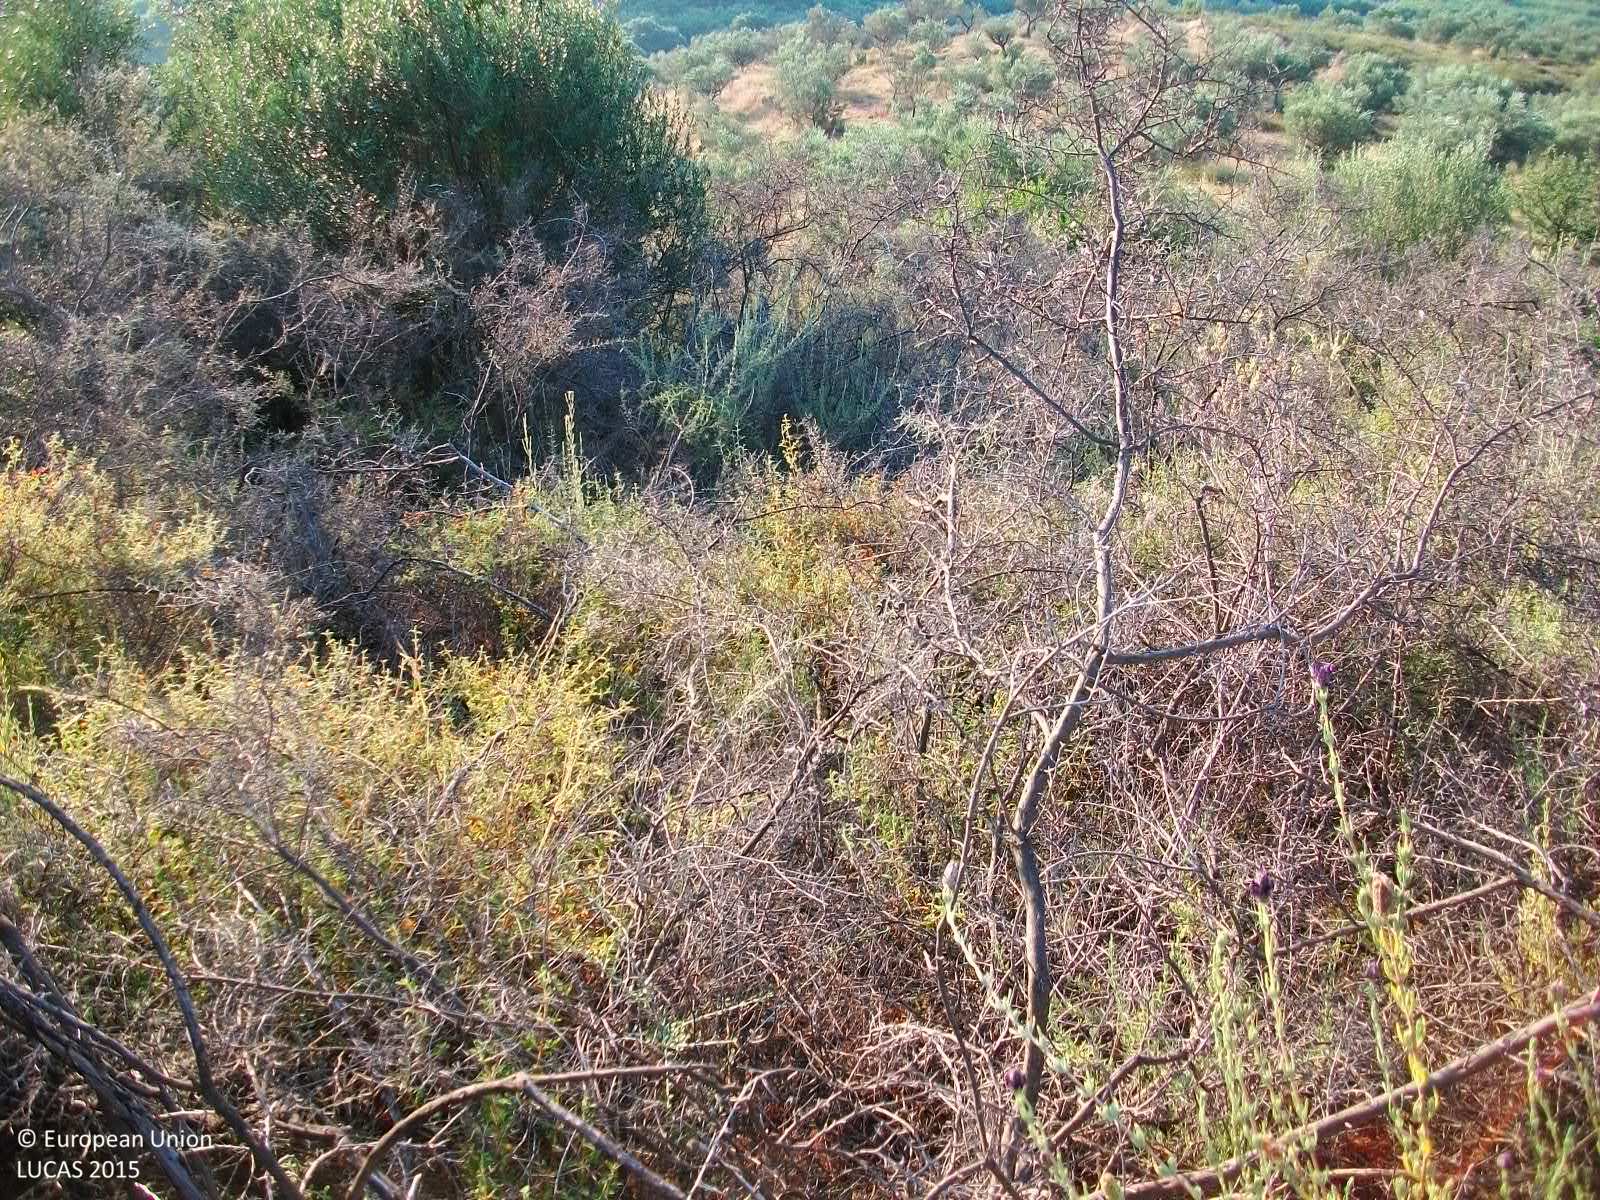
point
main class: Shrubland
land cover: Shrubland without tree cover
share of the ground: > 75 %
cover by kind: shrubs 100 %
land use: Semi-natural and natural areas not in use
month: July
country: GR
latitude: 37.1715
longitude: 21.9716
